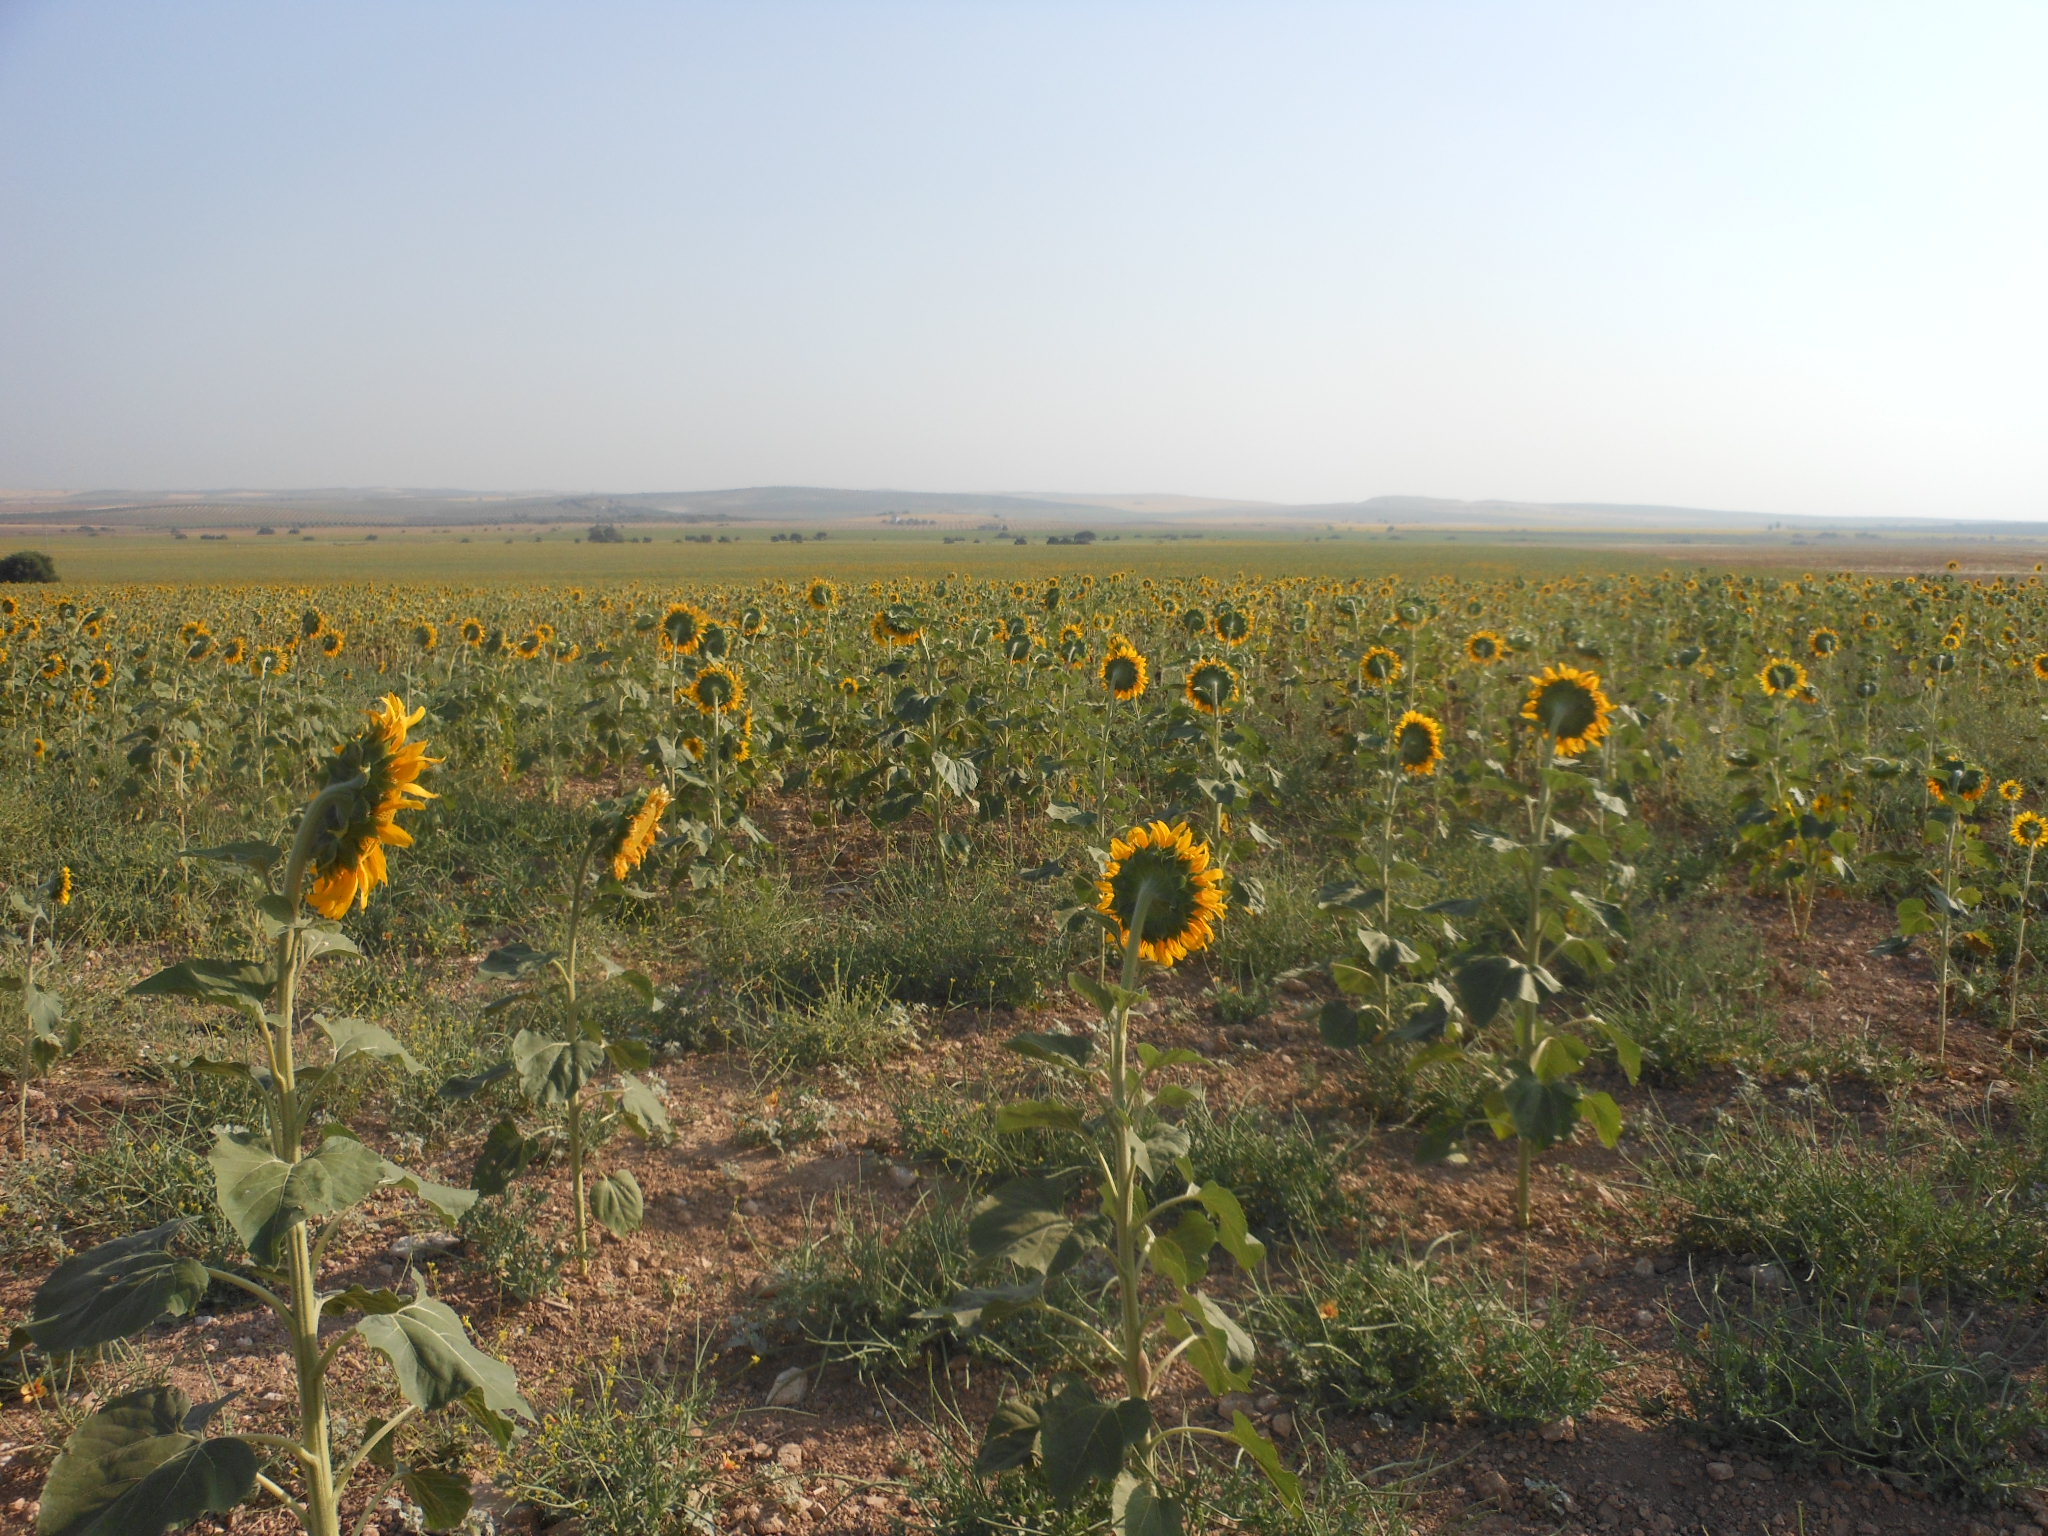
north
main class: Cropland
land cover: Sunflower
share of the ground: 25 - 50 %
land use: Agriculture (excluding fallow land and kitchen gardens)
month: June
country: ES
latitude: 37.2942
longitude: -5.0677
